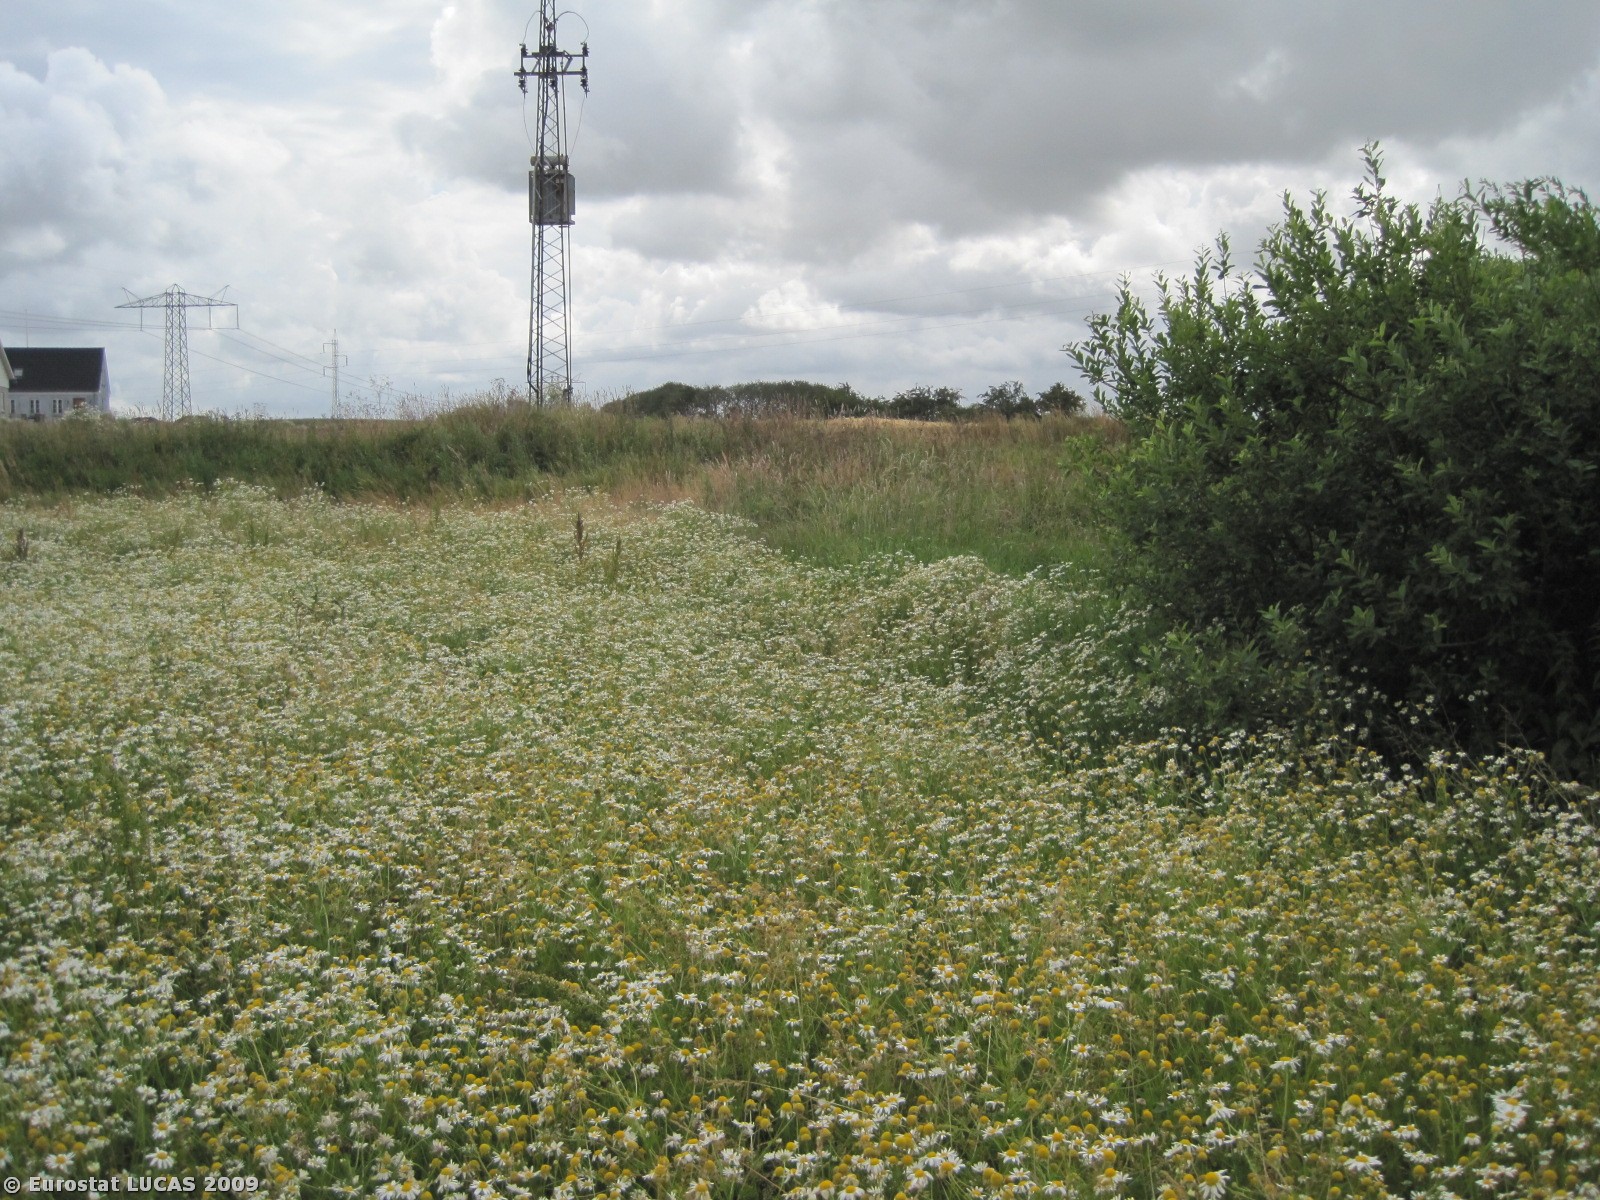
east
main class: Grassland
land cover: Grassland without tree/shrub cover
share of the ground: > 75 %
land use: Unused
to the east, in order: Grassland without tree/shrub cover; Tracks; Grassland without tree/shrub cover; Electric lines; Grass margins; Bare land; Grass margins; Tracks; Grass margins; Oats; Electric lines; Oats
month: July
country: DK
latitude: 56.3971
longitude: 8.7216
